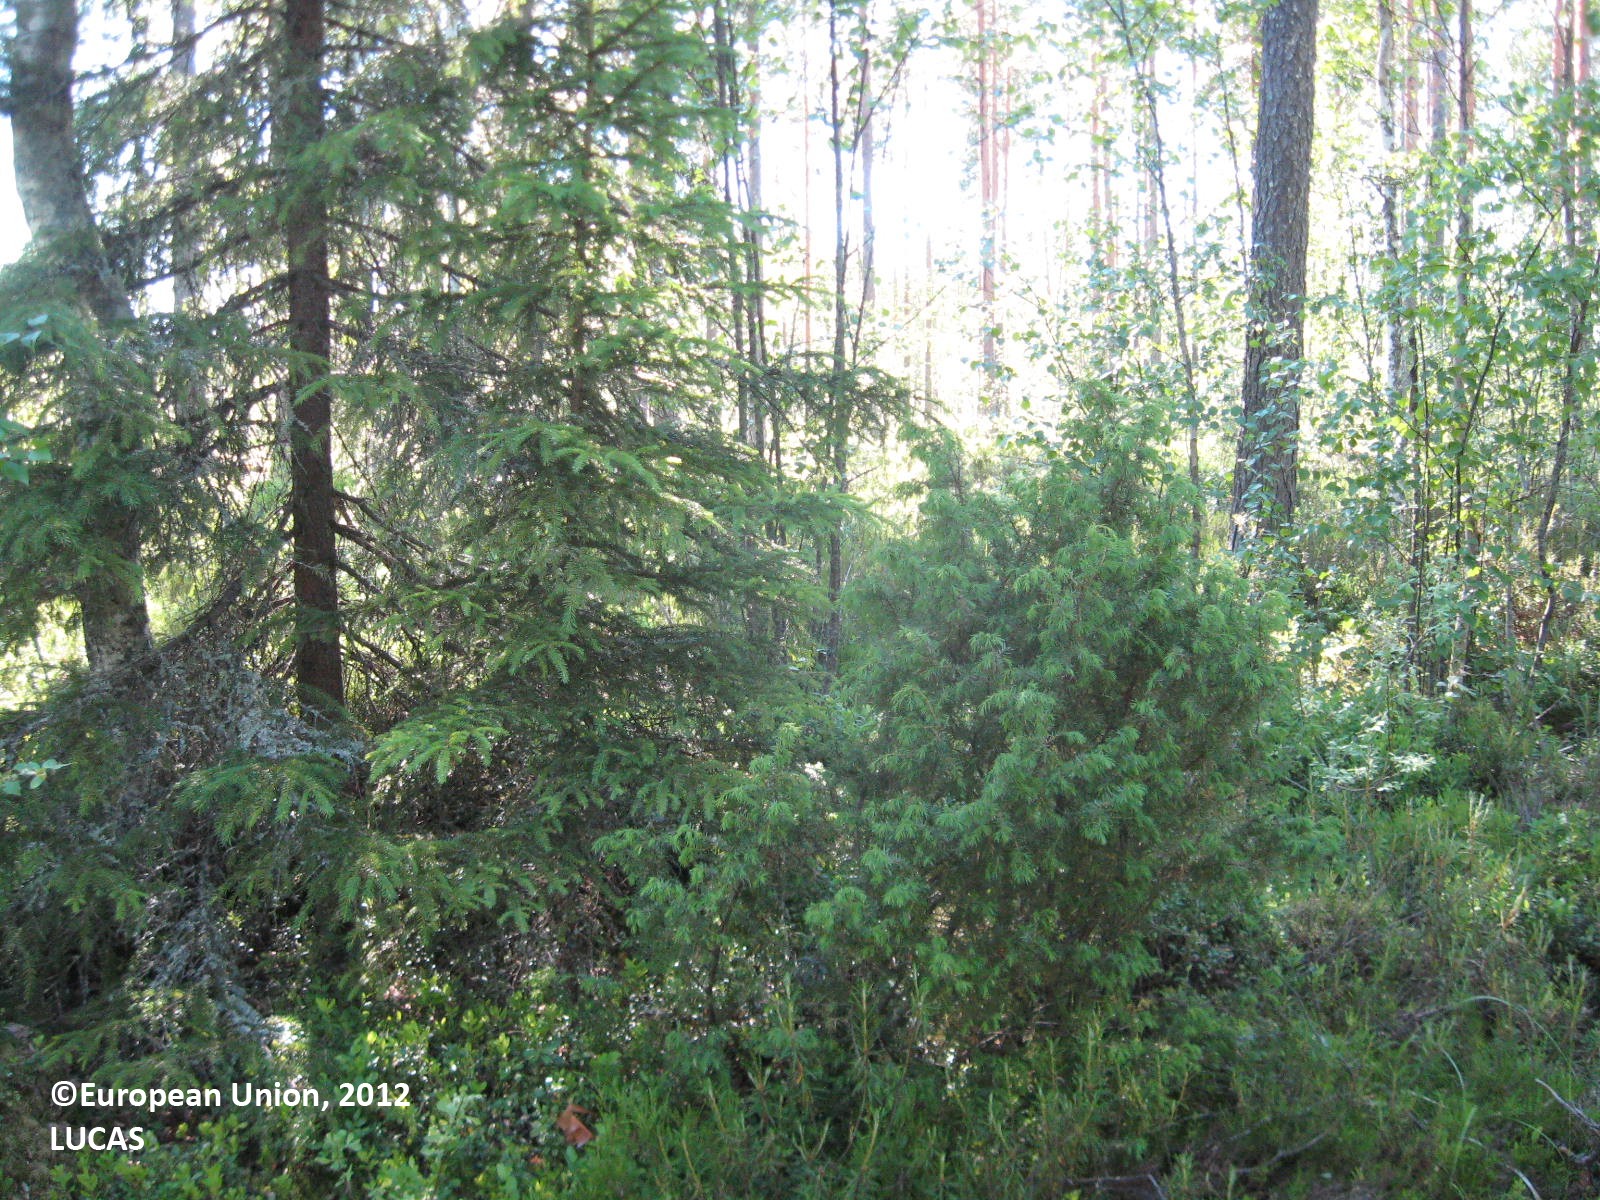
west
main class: Woodland
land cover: Other mixed woodland
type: boreal forest
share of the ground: > 75 %
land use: Forestry
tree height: > 5 m
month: July
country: FI
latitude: 62.6992
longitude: 22.8598
